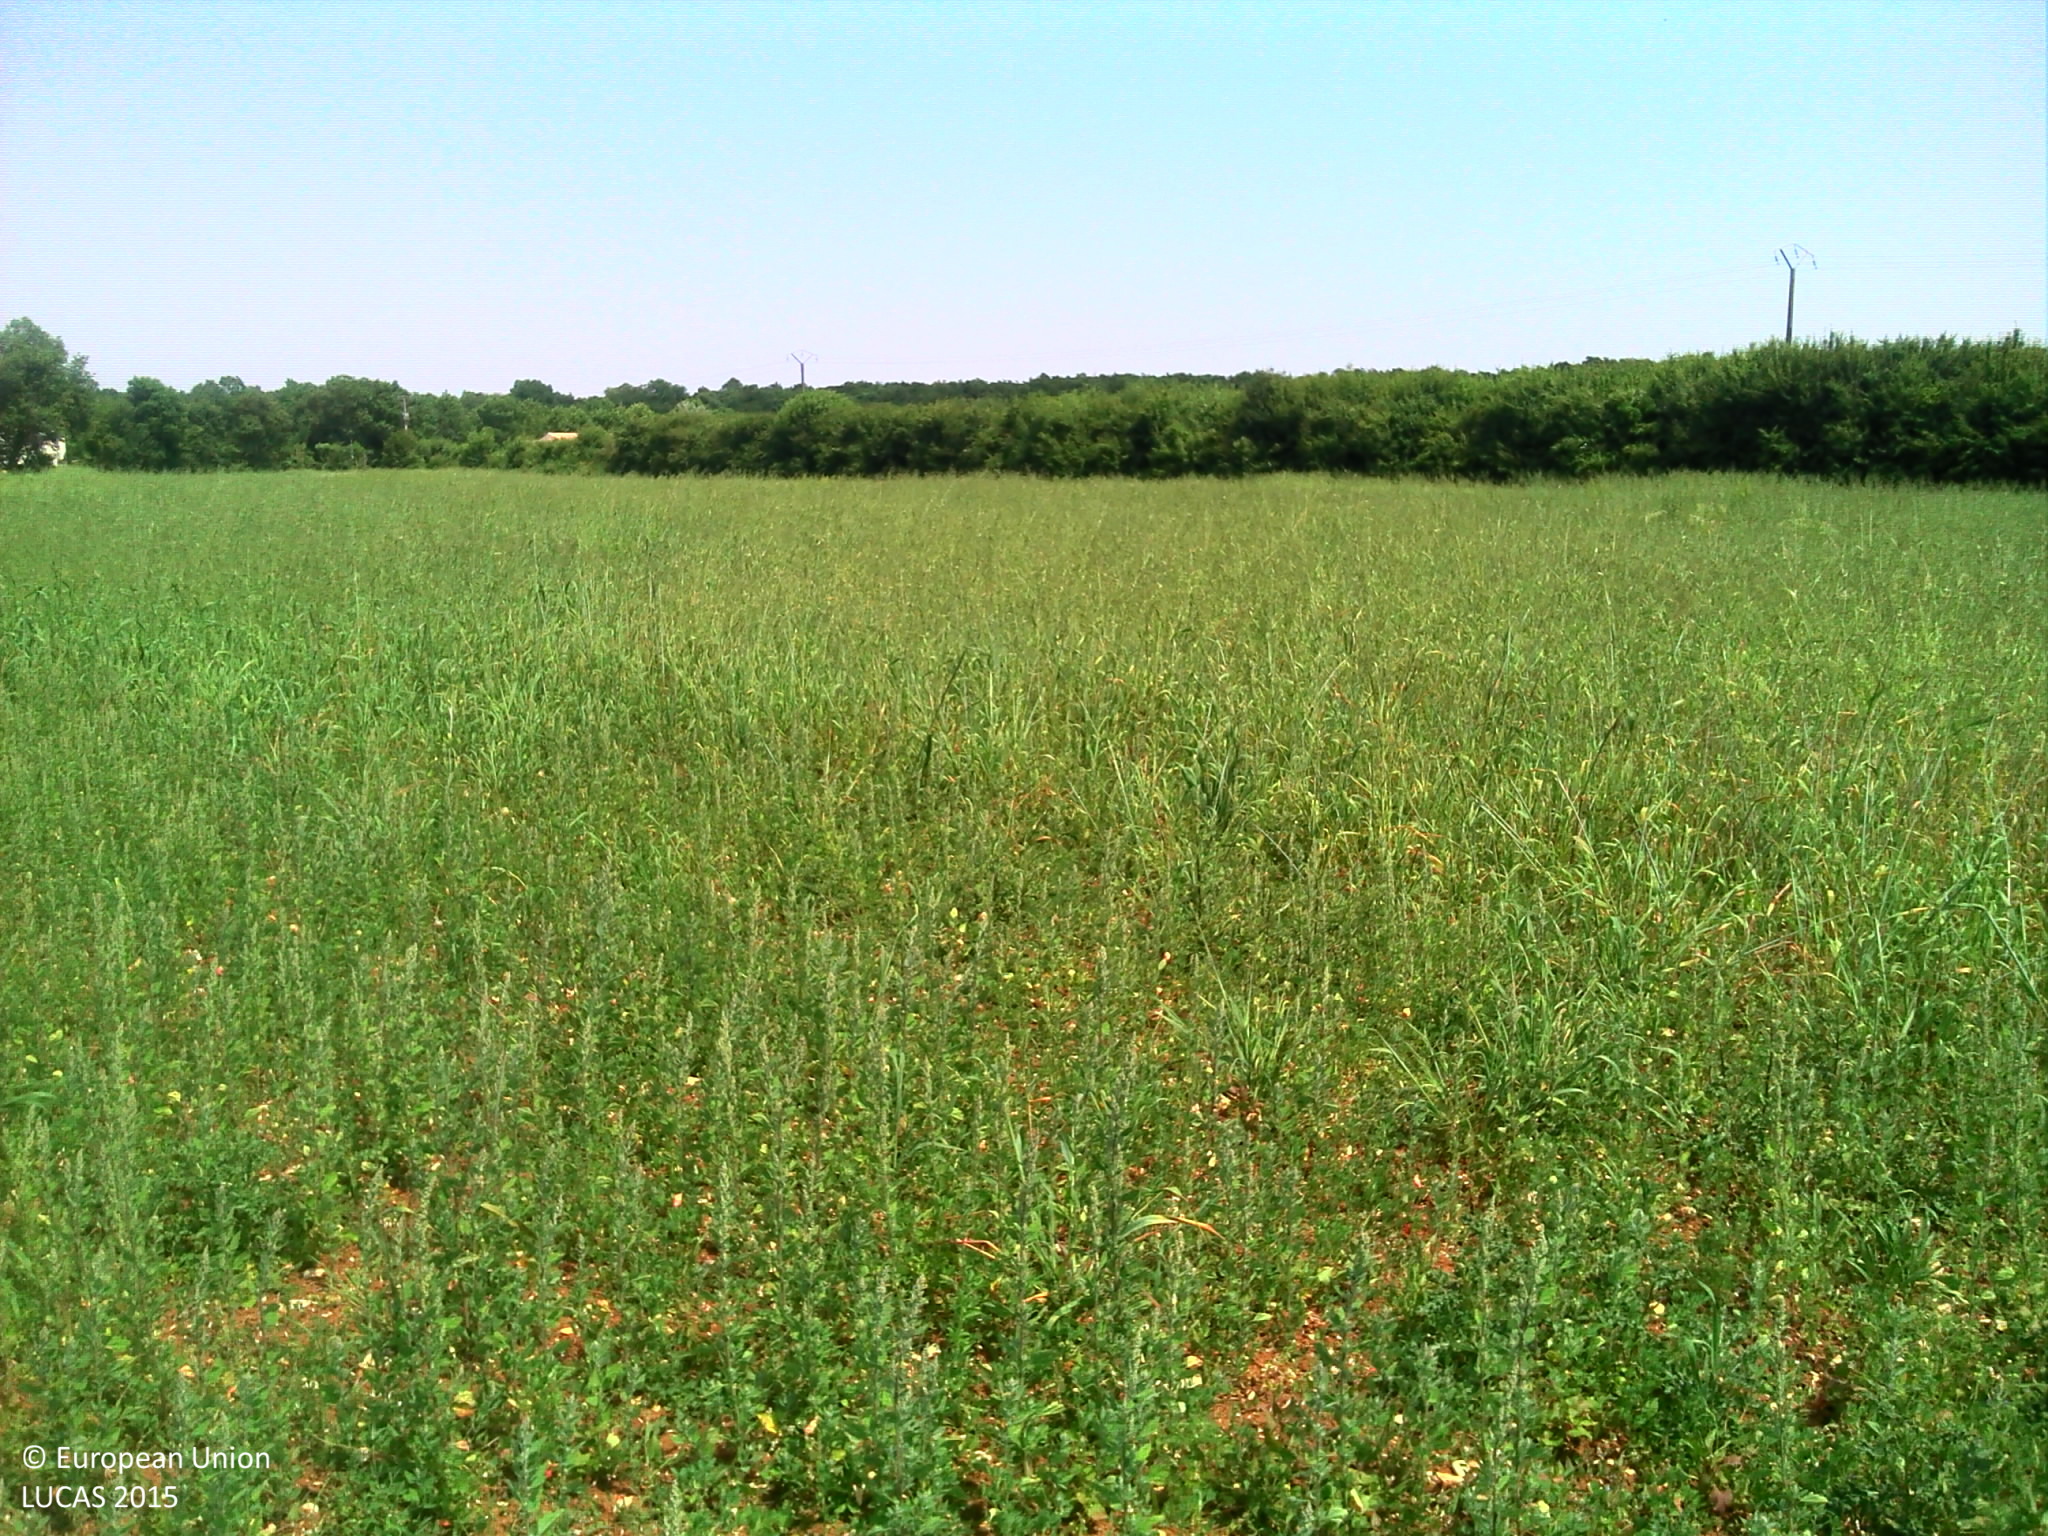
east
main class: Grassland
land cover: Spontaneously vegetated surfaces
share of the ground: > 75 %
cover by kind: herbaceous plants 95 %, shrubs 5 %
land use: Fallow land
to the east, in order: Spontaneously vegetated surfaces; Managed hedges; Fences; Managed hedges; Common wheat; Fences; Managed hedges; Other bare soil
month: June
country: FR
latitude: 46.1874
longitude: -0.7685
